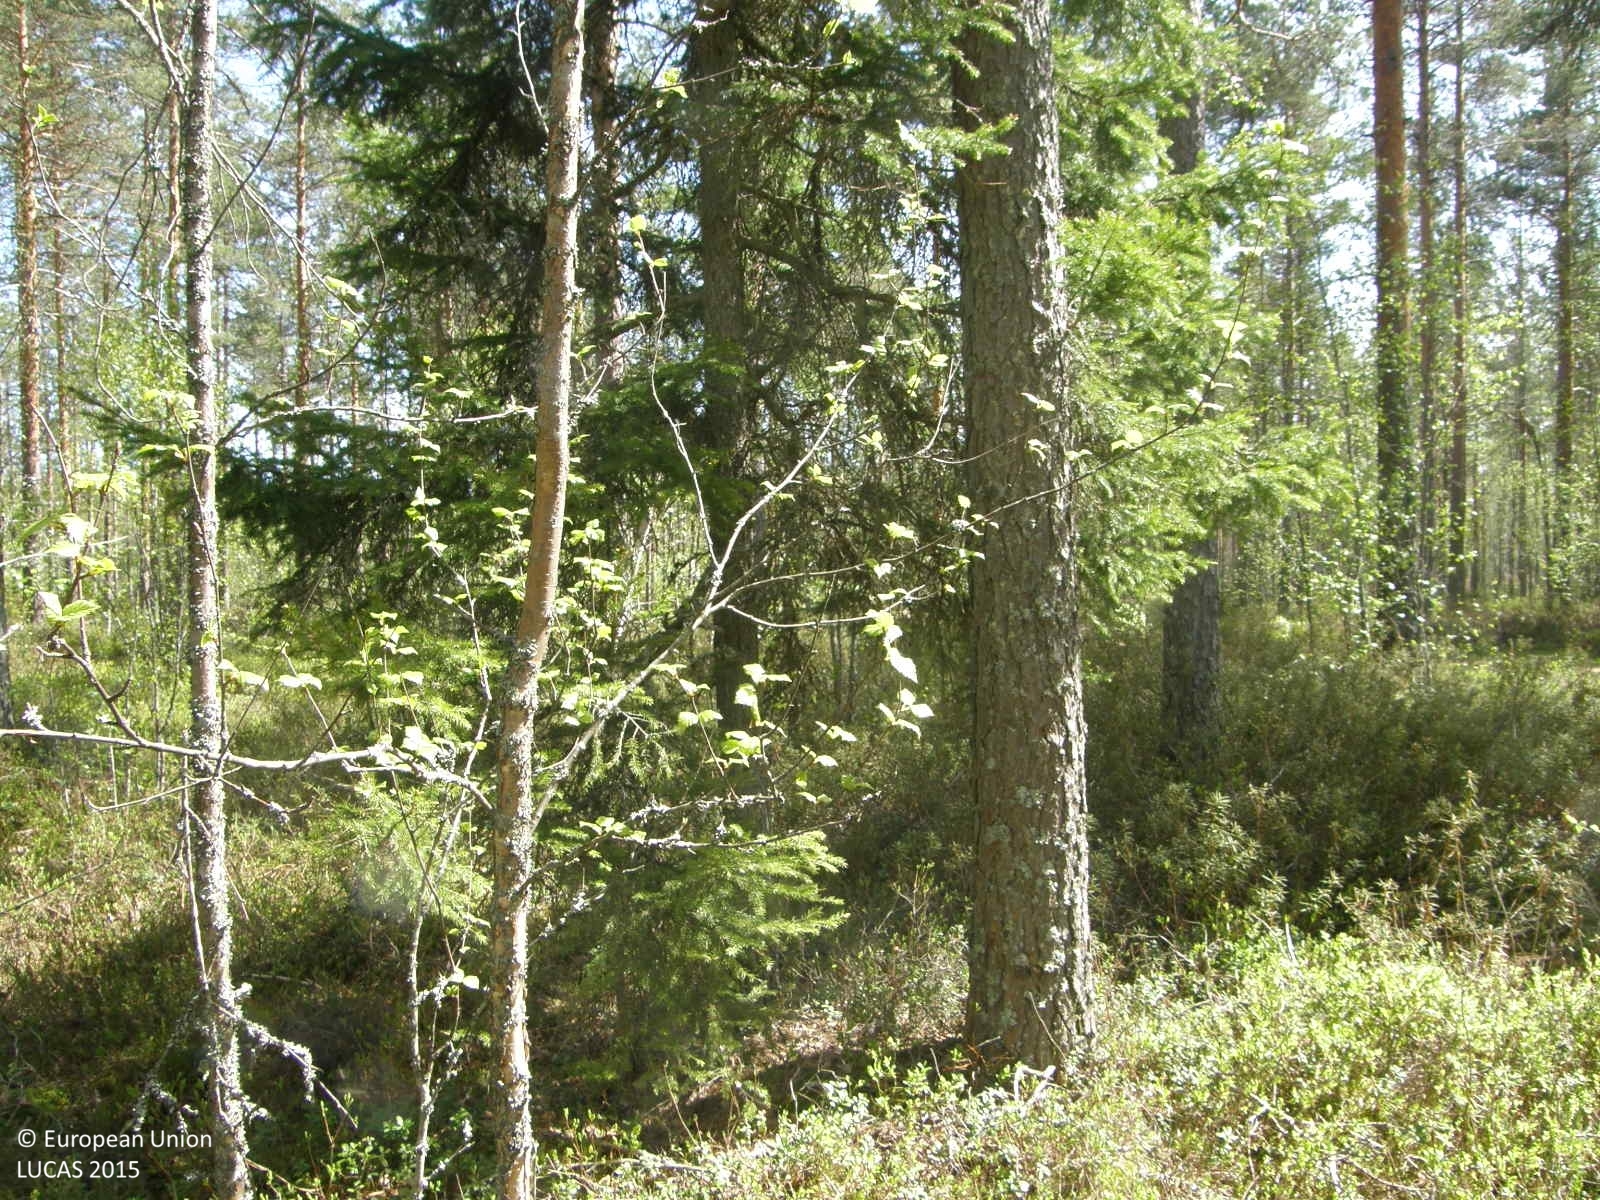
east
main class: Woodland
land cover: Pine dominated coniferous woodland
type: boreal forest
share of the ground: > 75 %
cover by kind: coniferous forest trees 75 %, shrubs 15 %, broadleaved forest trees 10 %
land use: Forestry
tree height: > 5 m
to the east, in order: Pine dominated coniferous woodland; Ditches and canals; Pine dominated coniferous woodland; Tracks; Ditches and canals; Pine dominated coniferous woodland; Ditches and canals; Pine dominated coniferous woodland; Ditches and canals; Pine dominated coniferous woodland; Ditches and canals; Pine dominated coniferous woodland; Ditches and canals; Pine dominated coniferous woodland; Ditches and canals; Pine dominated coniferous woodland
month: June
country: FI
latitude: 62.1590
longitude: 22.3209
